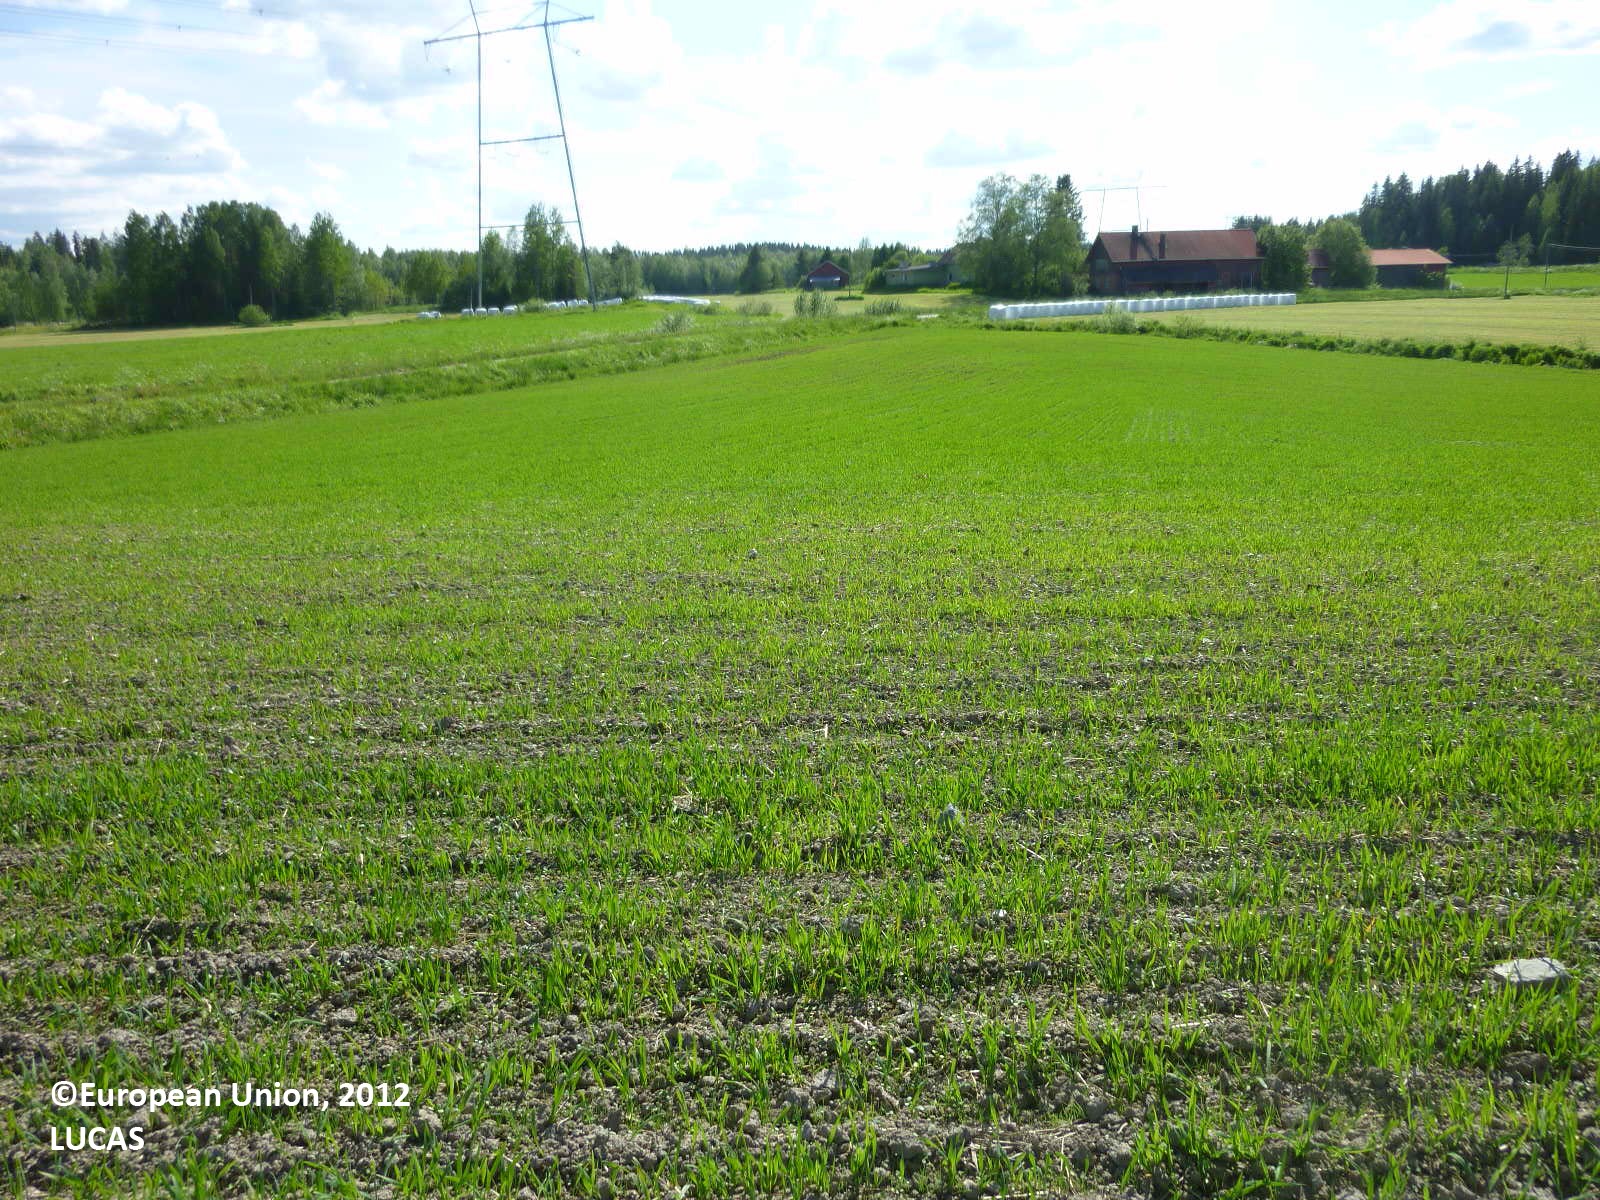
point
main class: Cropland
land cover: Oats
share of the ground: > 75 %
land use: Agriculture (excluding fallow land and kitchen gardens)
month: June
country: FI
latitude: 61.4233
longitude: 22.7933
